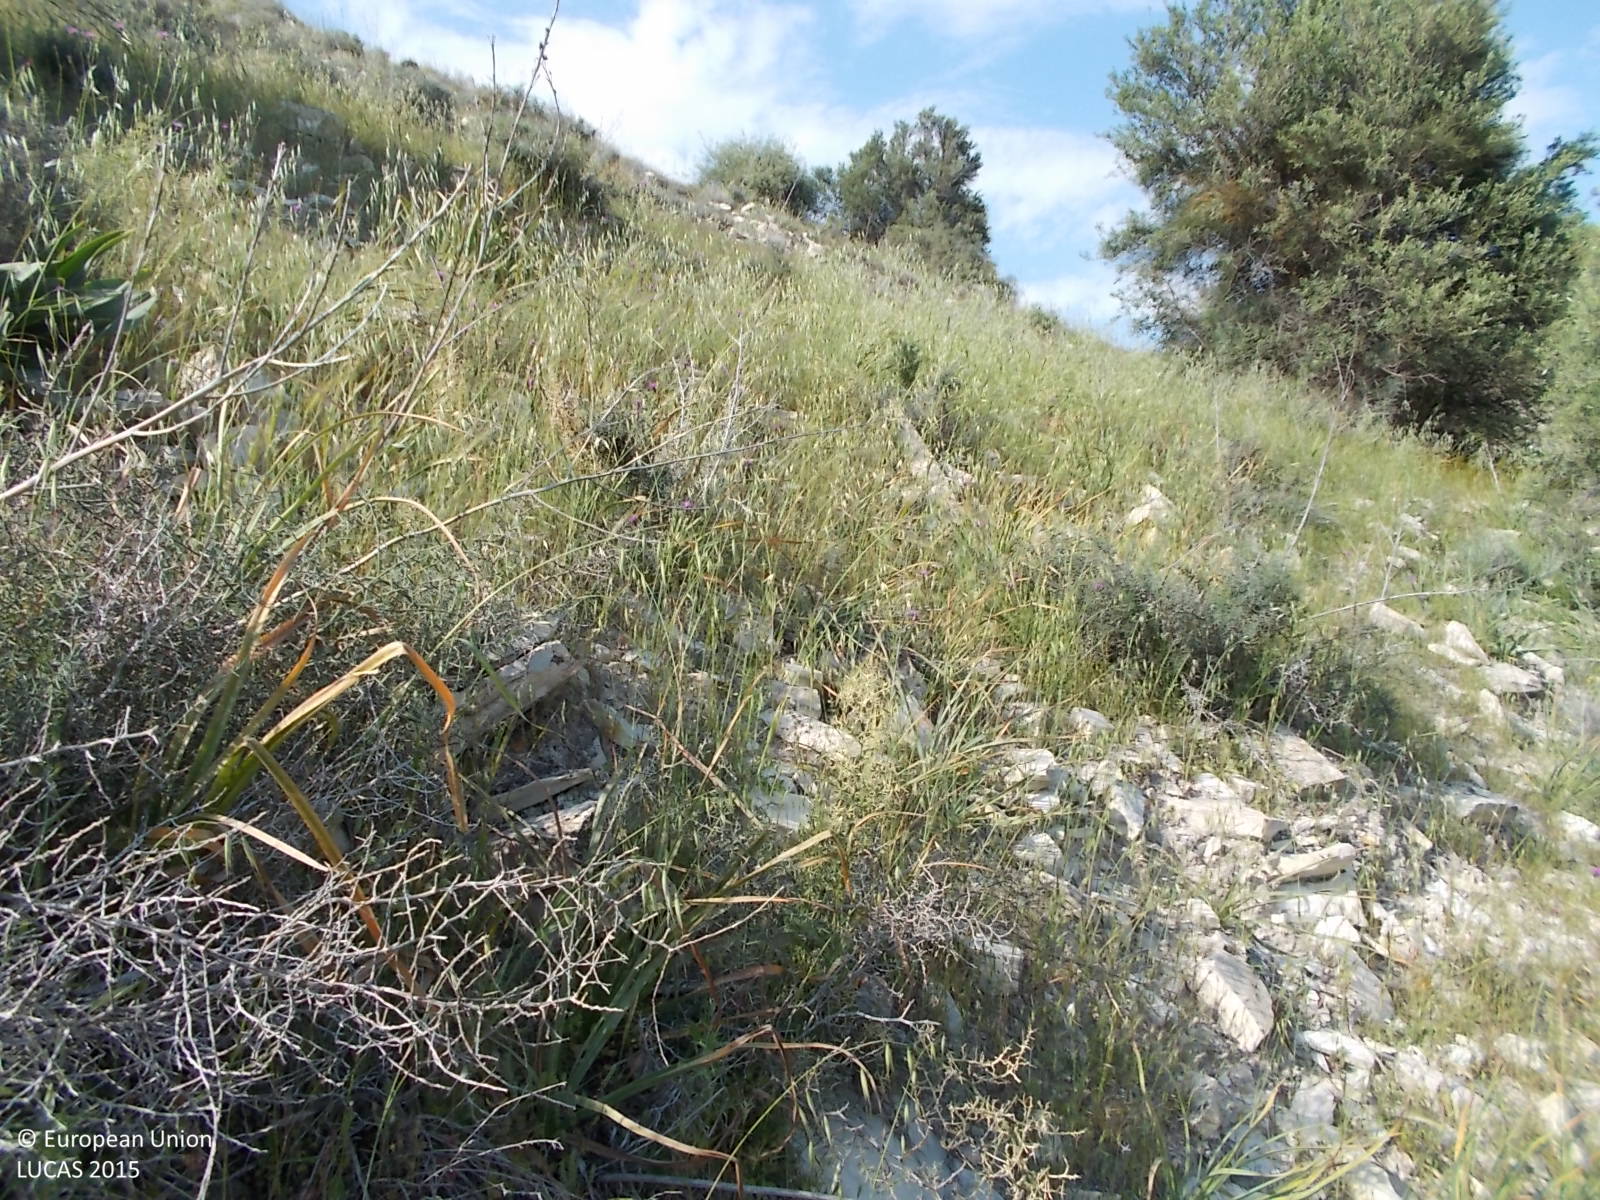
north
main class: Cropland
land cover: Olive groves
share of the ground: 25 - 50 %
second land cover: Grassland without tree/shrub cover
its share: > 75 %
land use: Abandoned areas
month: April
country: CY
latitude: 34.9507
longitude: 33.4826
